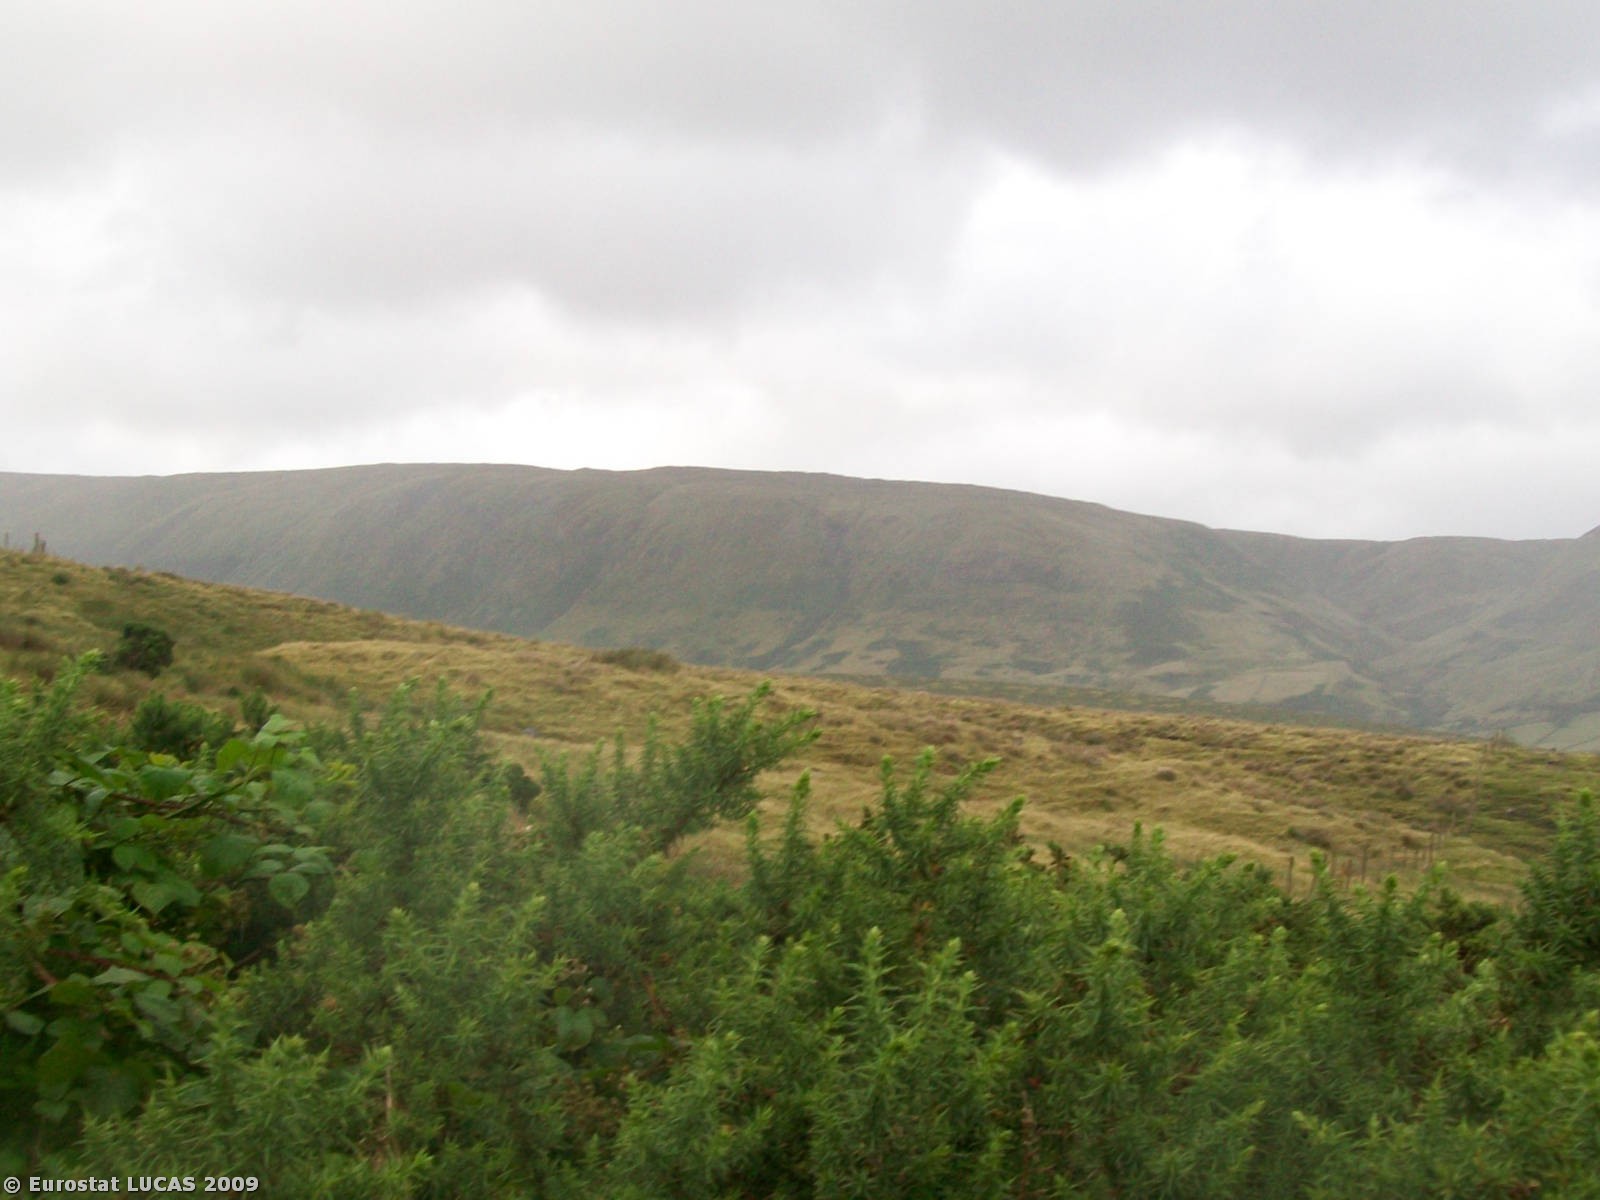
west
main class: Grassland
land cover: Grassland without tree/shrub cover
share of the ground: > 75 %
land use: Agriculture (excluding fallow land and kitchen gardens)
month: July
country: IE
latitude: 53.6094
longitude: -9.5034
